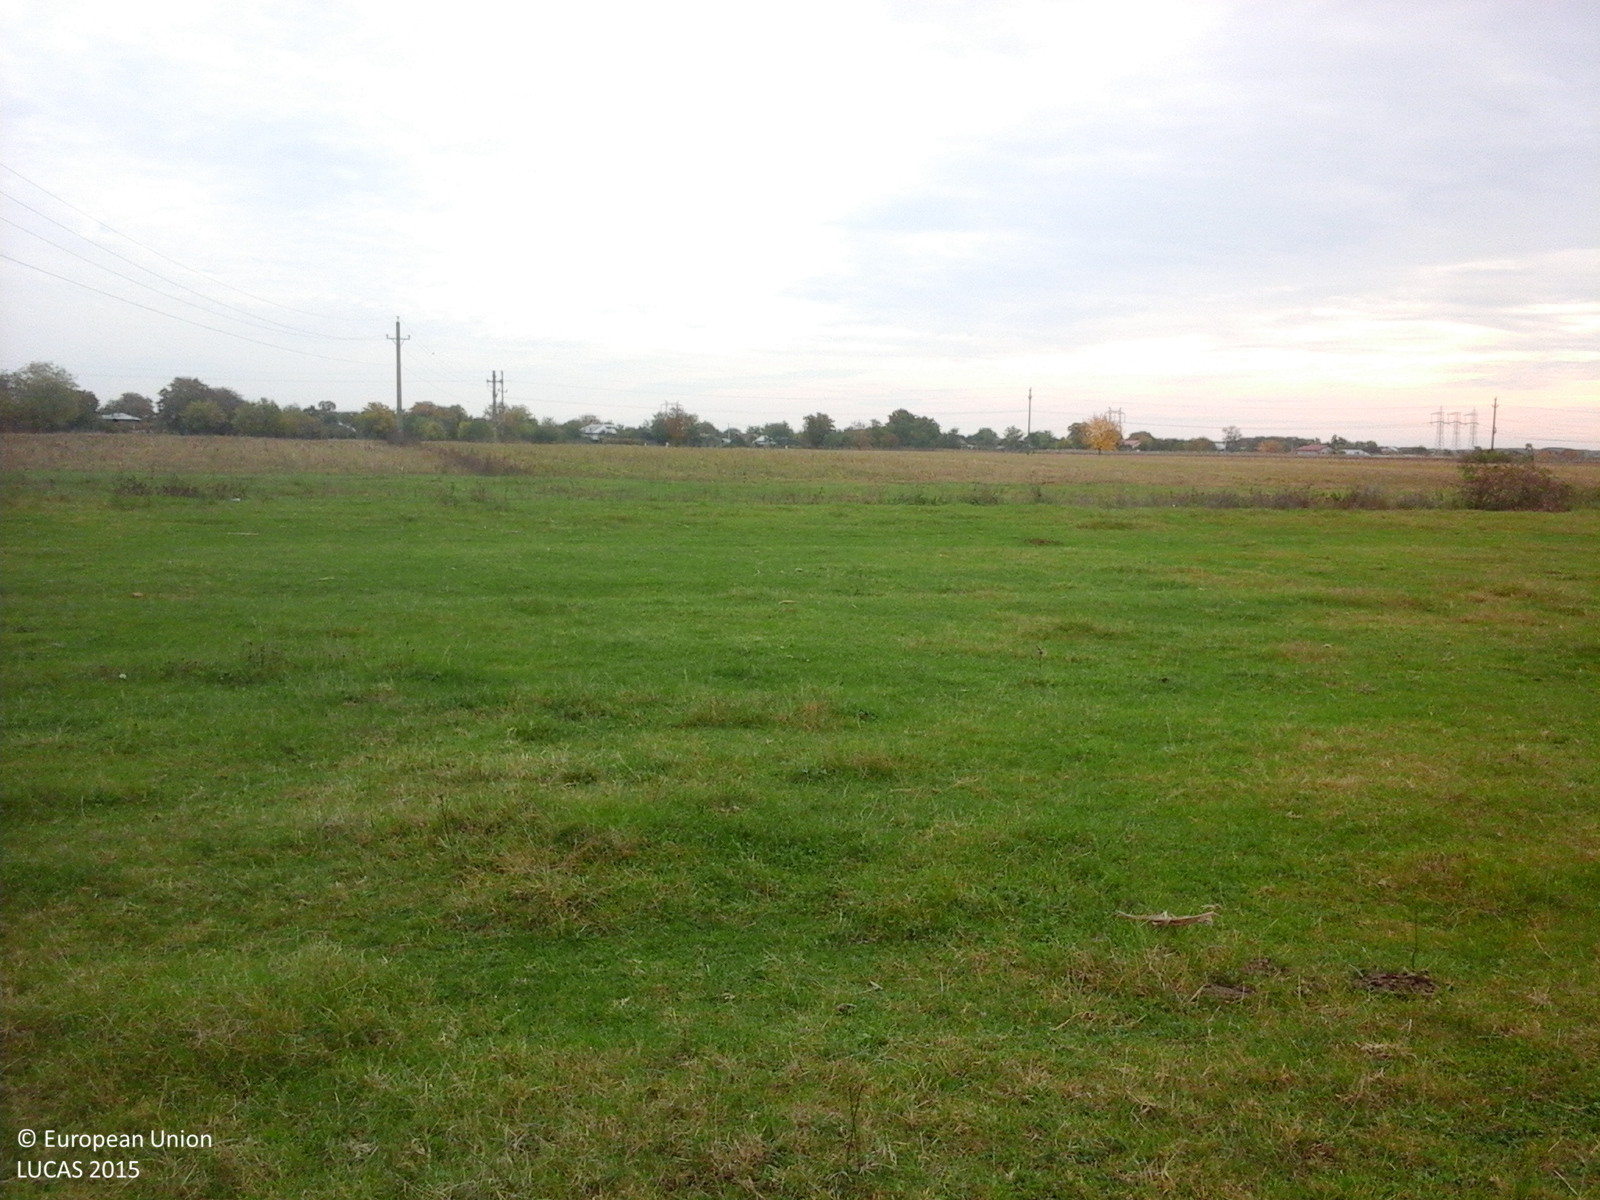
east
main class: Grassland
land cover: Grassland without tree/shrub cover
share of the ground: > 75 %
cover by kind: herbaceous plants 100 %
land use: Agriculture (excluding fallow land and kitchen gardens)
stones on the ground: < 10 %
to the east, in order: Grassland without tree/shrub cover; Tracks; Grass margins; Ditches and canals; Grassland without tree/shrub cover
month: October
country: RO
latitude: 44.8478
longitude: 26.0889
